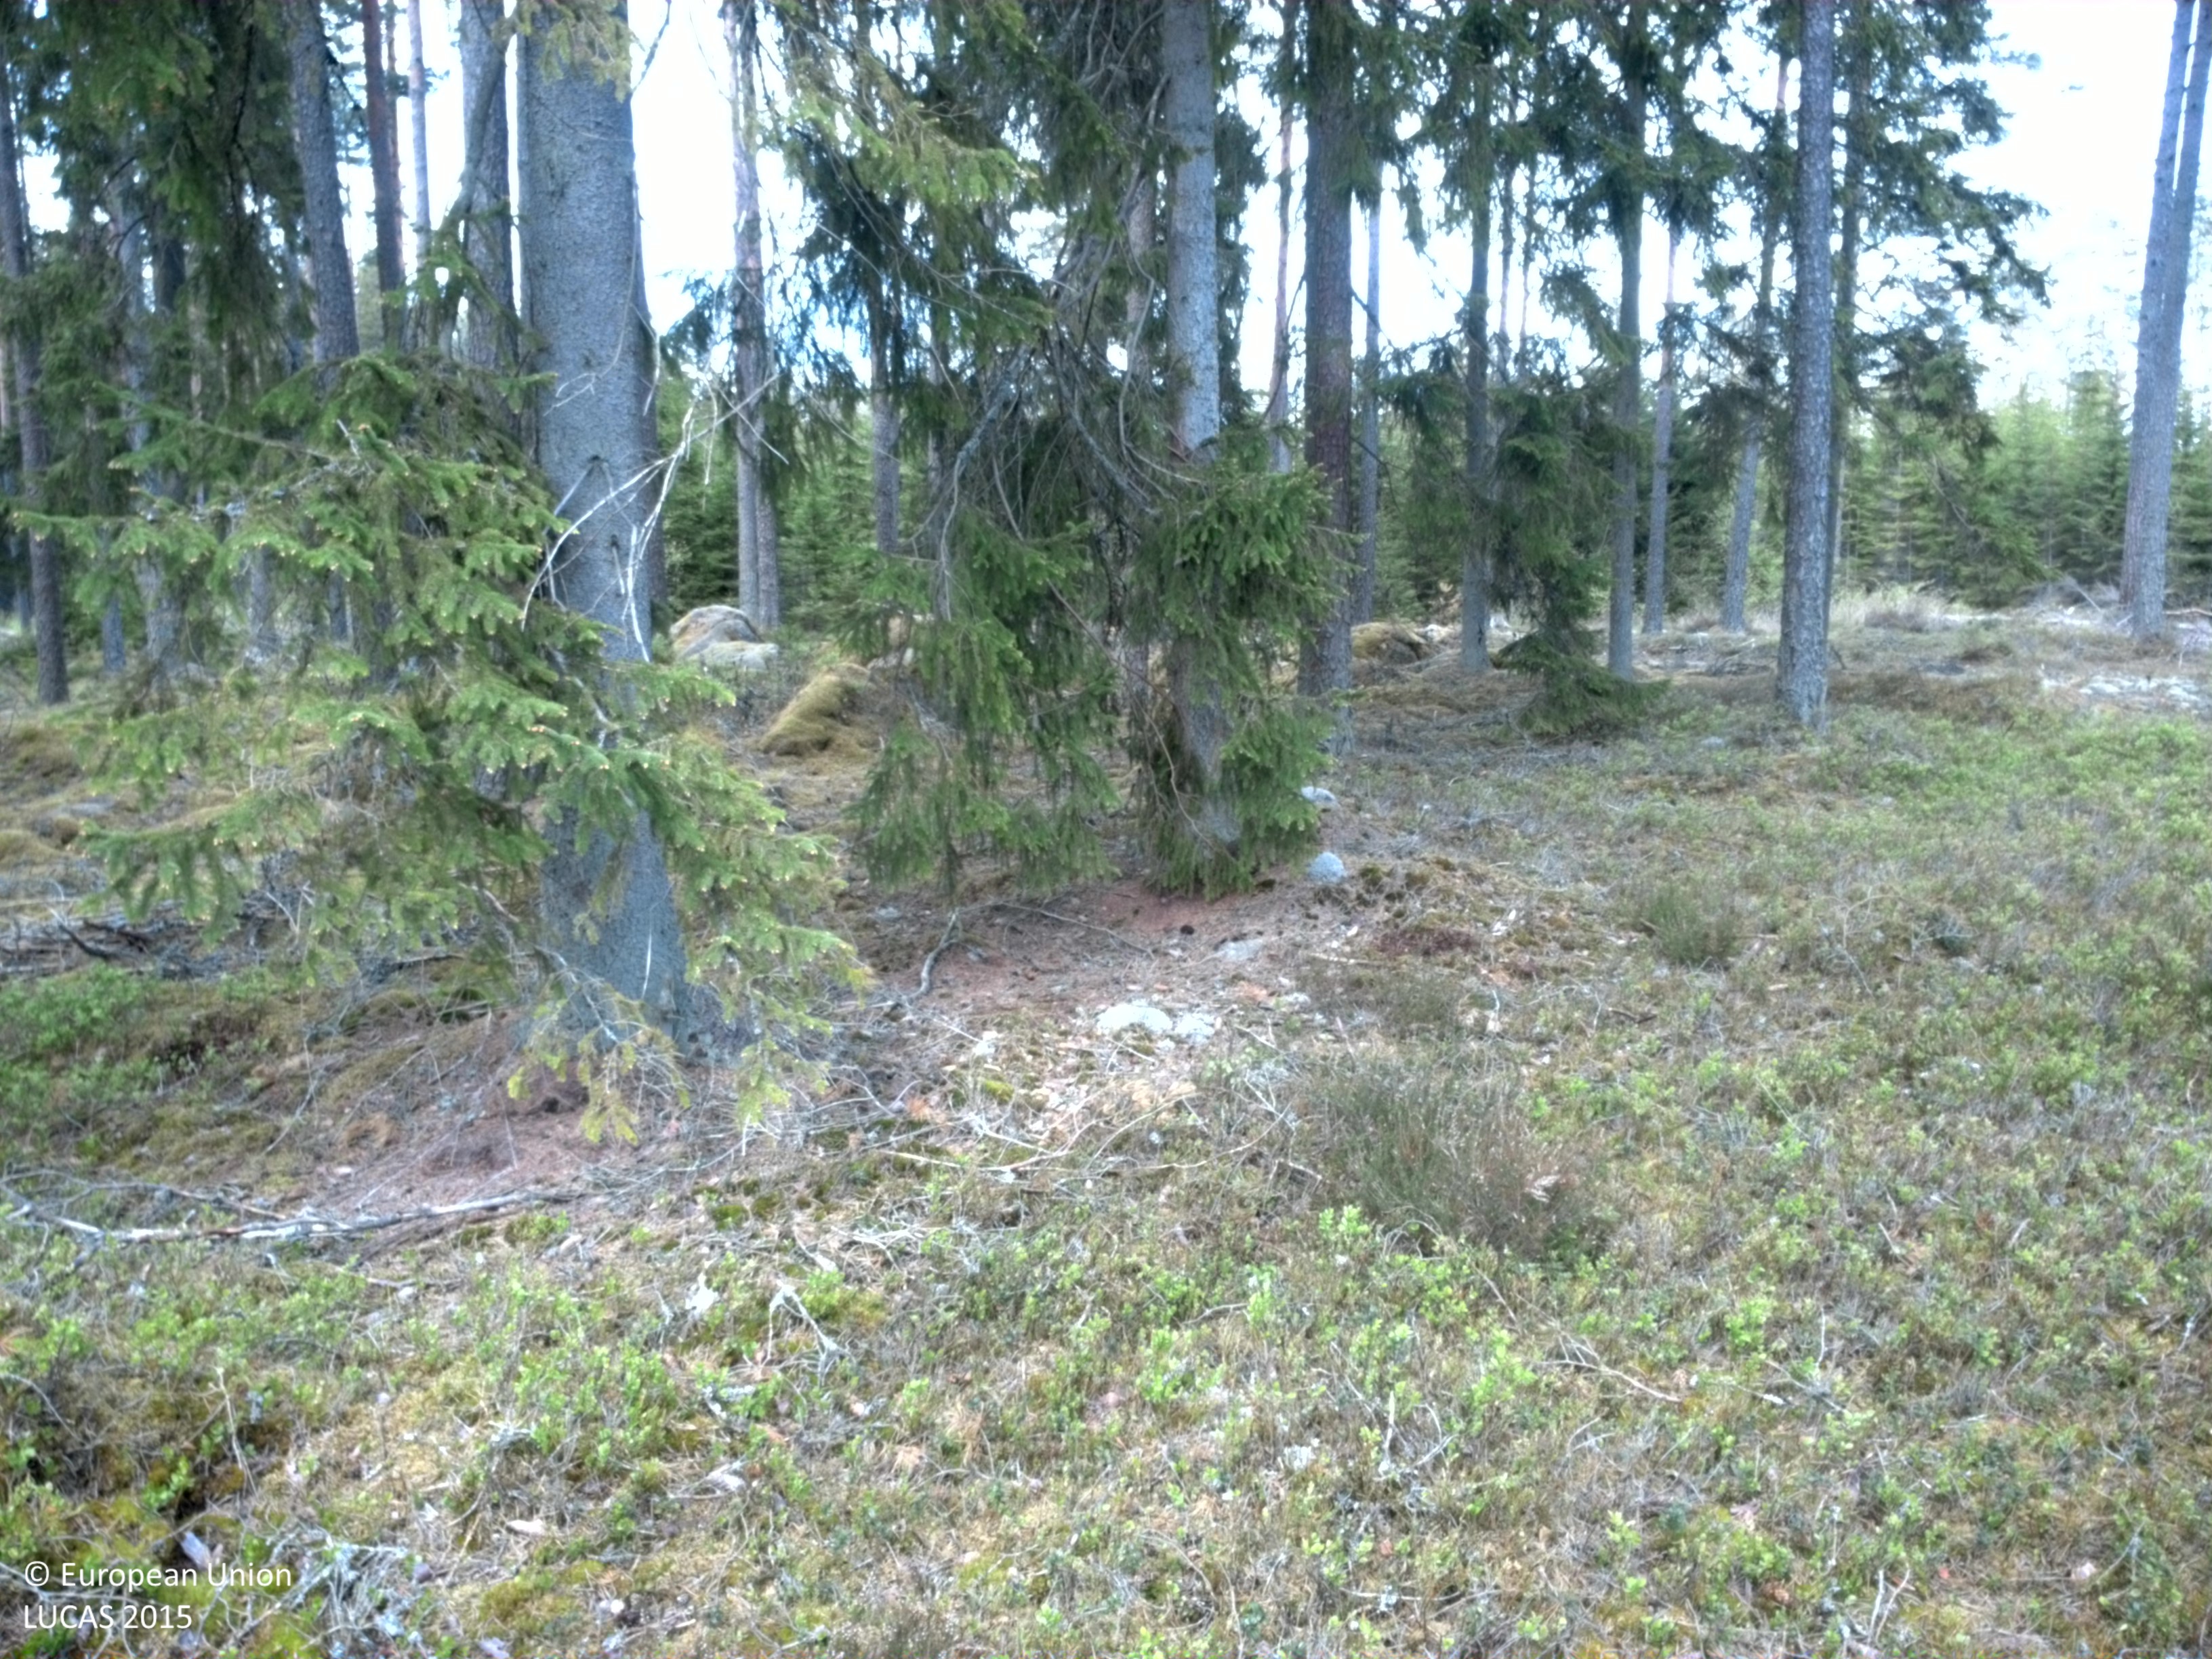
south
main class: Woodland
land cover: Pine dominated coniferous woodland
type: boreal forest
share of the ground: 50 - 75 %
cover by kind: coniferous forest trees 40 %, shrubs 35 %, lichens and mosses 15 %, broadleaved forest trees 10 %
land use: Forestry
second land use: Amenities, museums, leisure
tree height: > 5 m
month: May
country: SE
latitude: 56.8229
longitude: 15.1590
